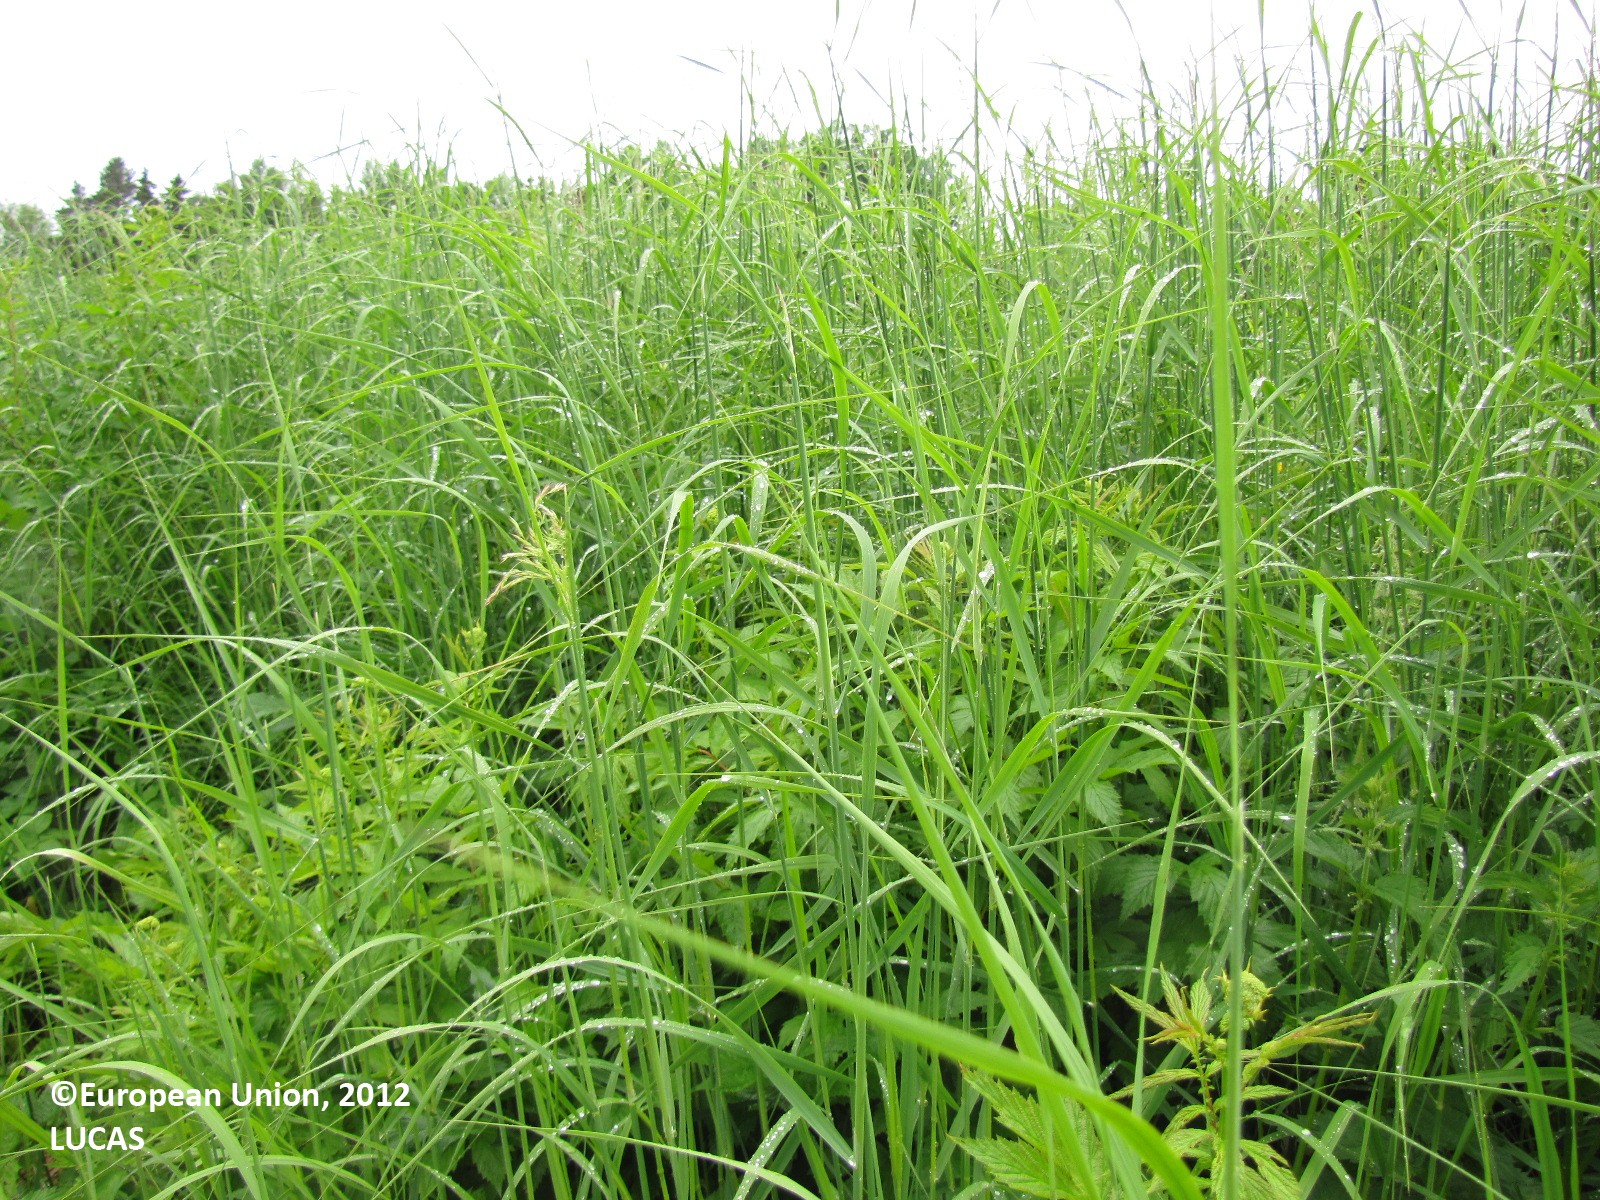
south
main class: Shrubland
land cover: Shrubland with sparse tree cover
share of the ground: 25 - 50 %
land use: Agriculture (excluding fallow land and kitchen gardens)
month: June
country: FI
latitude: 61.2964
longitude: 24.3382
